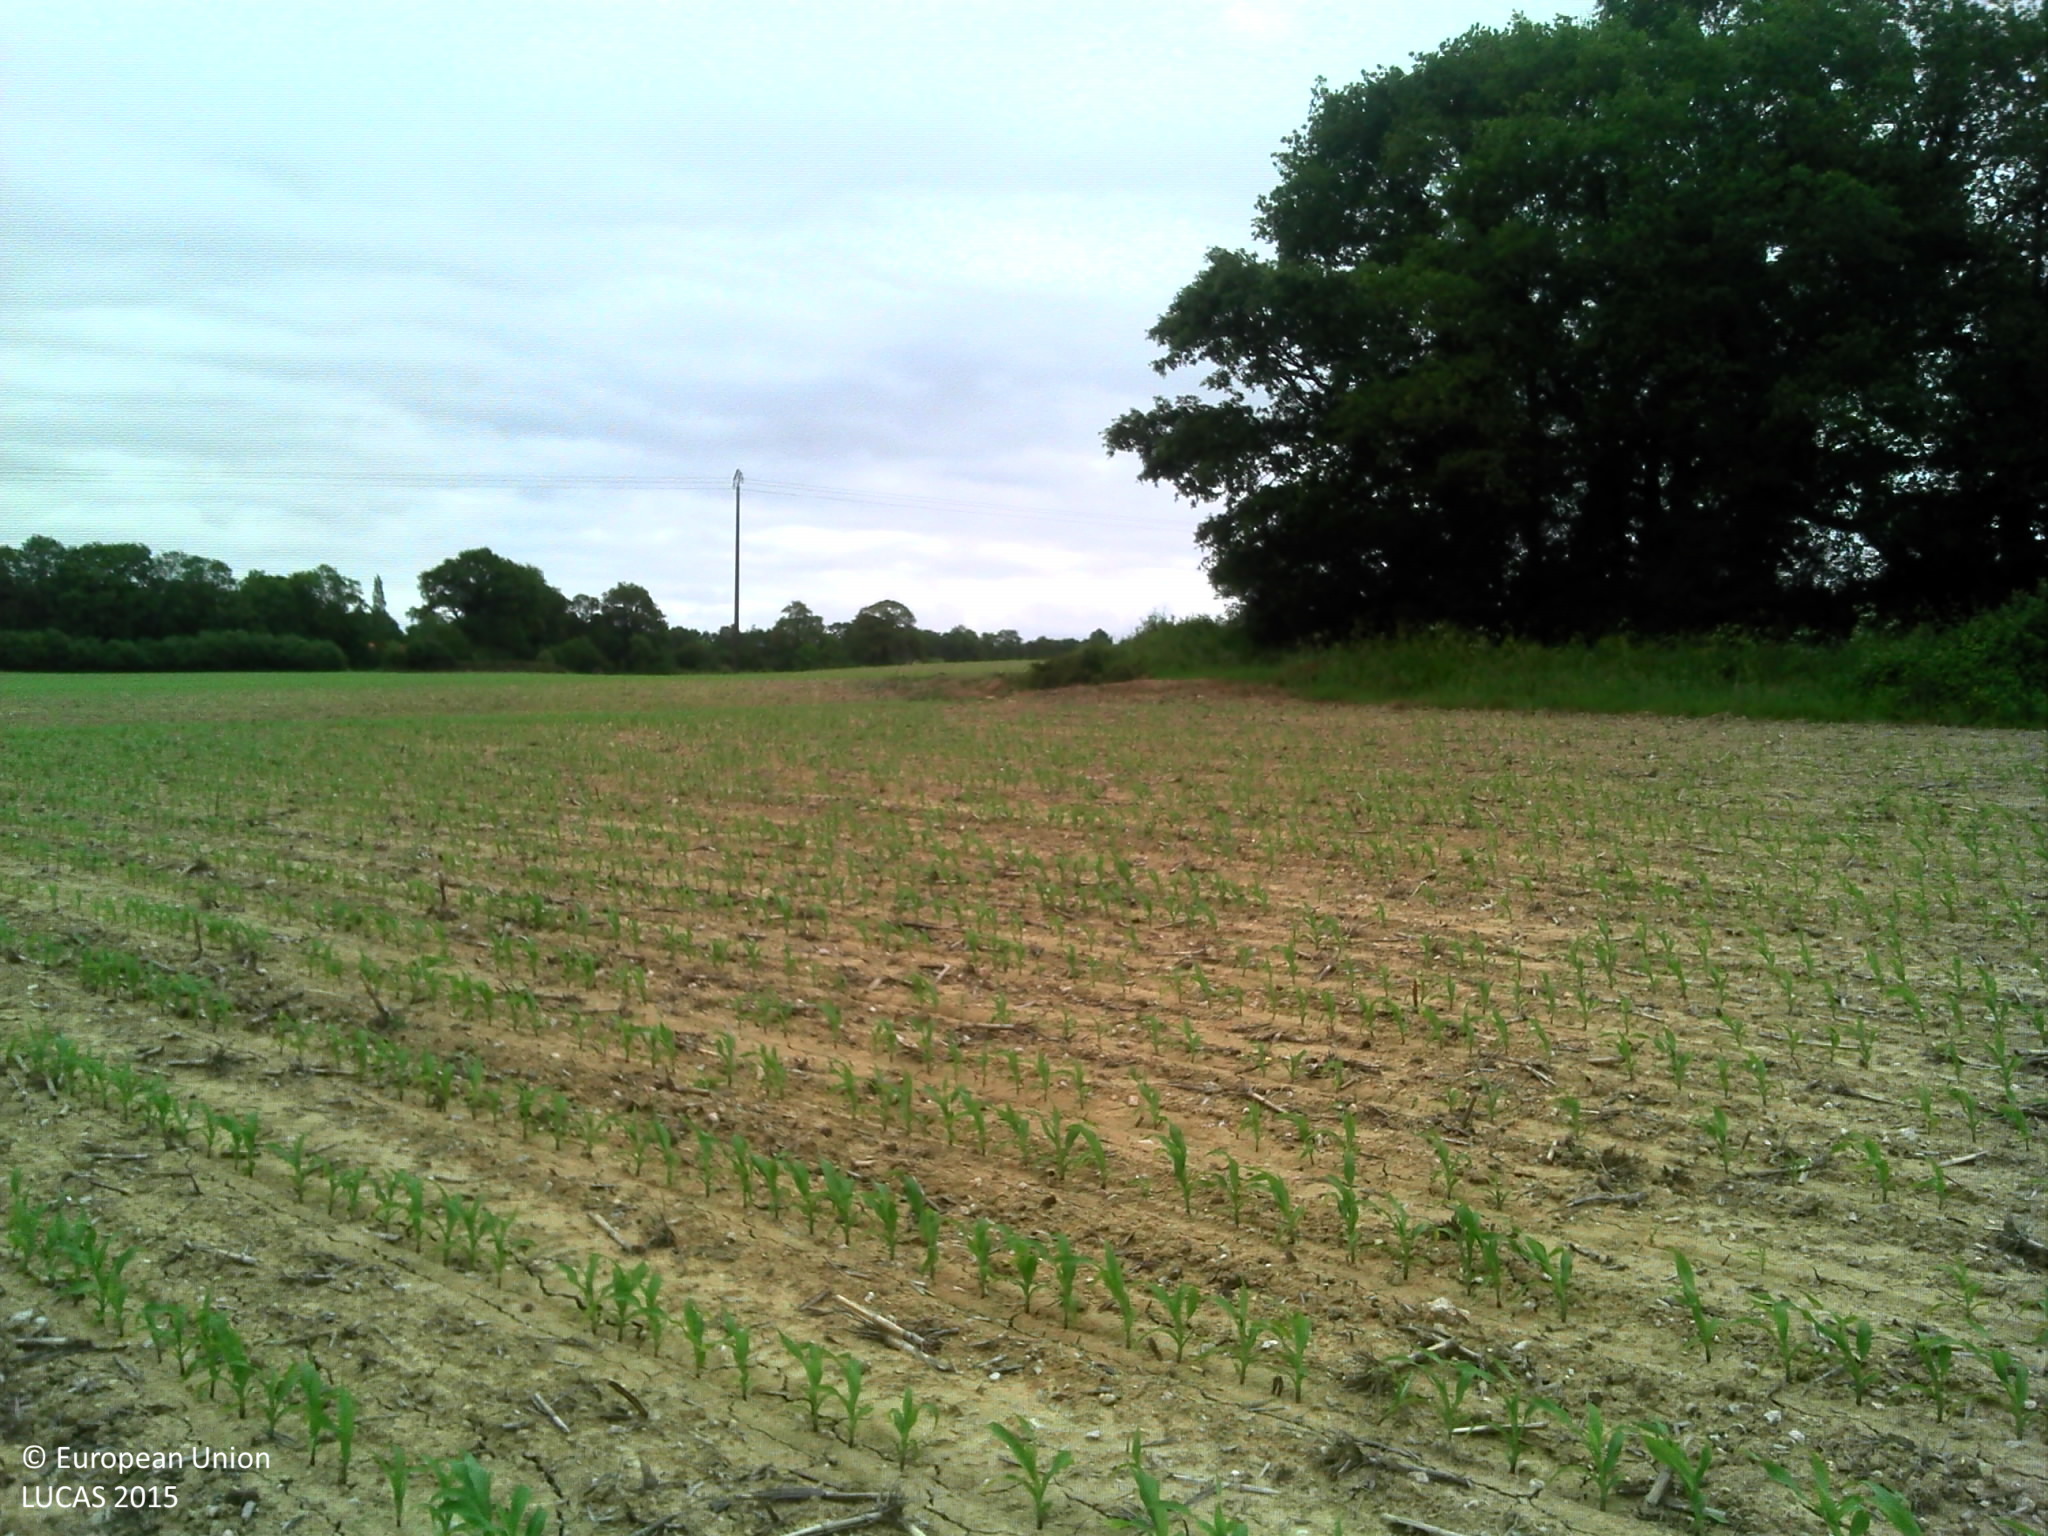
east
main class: Cropland
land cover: Maize
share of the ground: 10 - 25 %
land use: Agriculture (excluding fallow land and kitchen gardens)
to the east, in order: Maize; Electric lines; Maize
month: June
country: FR
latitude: 46.8943
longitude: -1.8174
